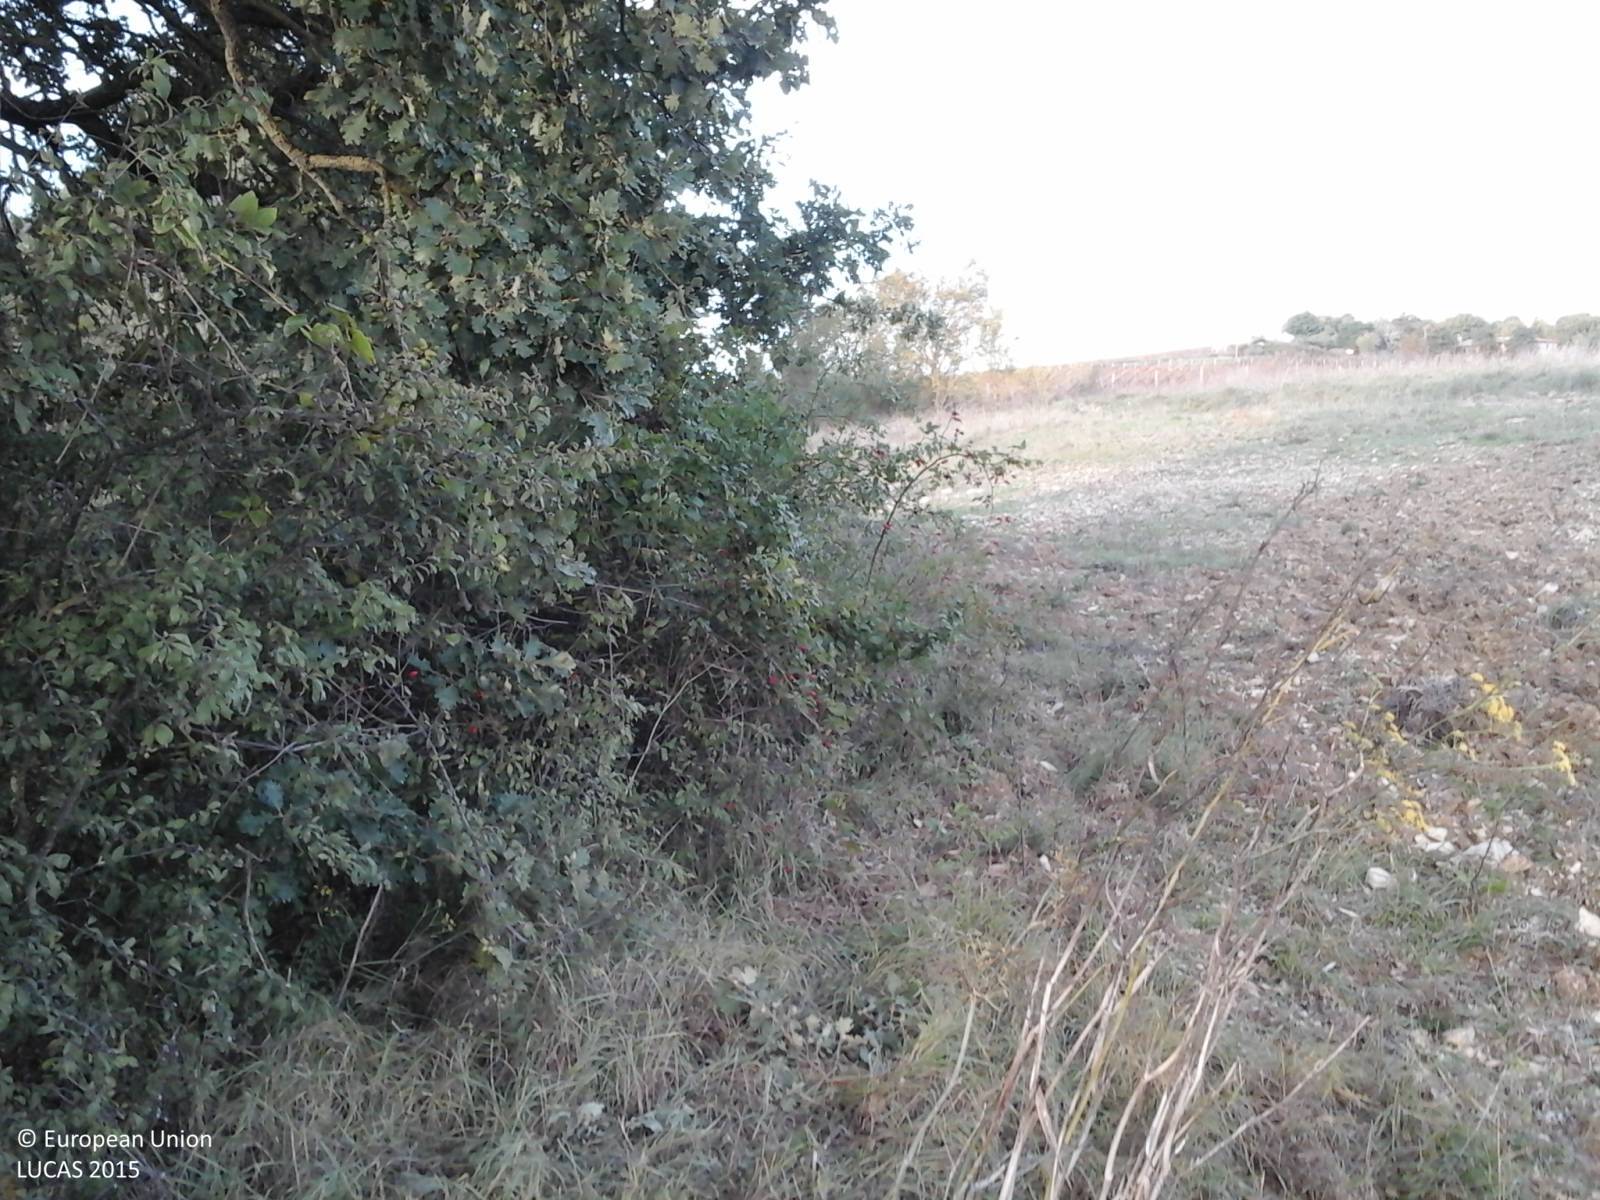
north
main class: Woodland
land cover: Broadleaved woodland
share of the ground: > 75 %
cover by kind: broadleaved forest trees 70 %, shrubs 30 %
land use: Agriculture (excluding fallow land and kitchen gardens)
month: October
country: IT
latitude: 42.7729
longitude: 12.2783
